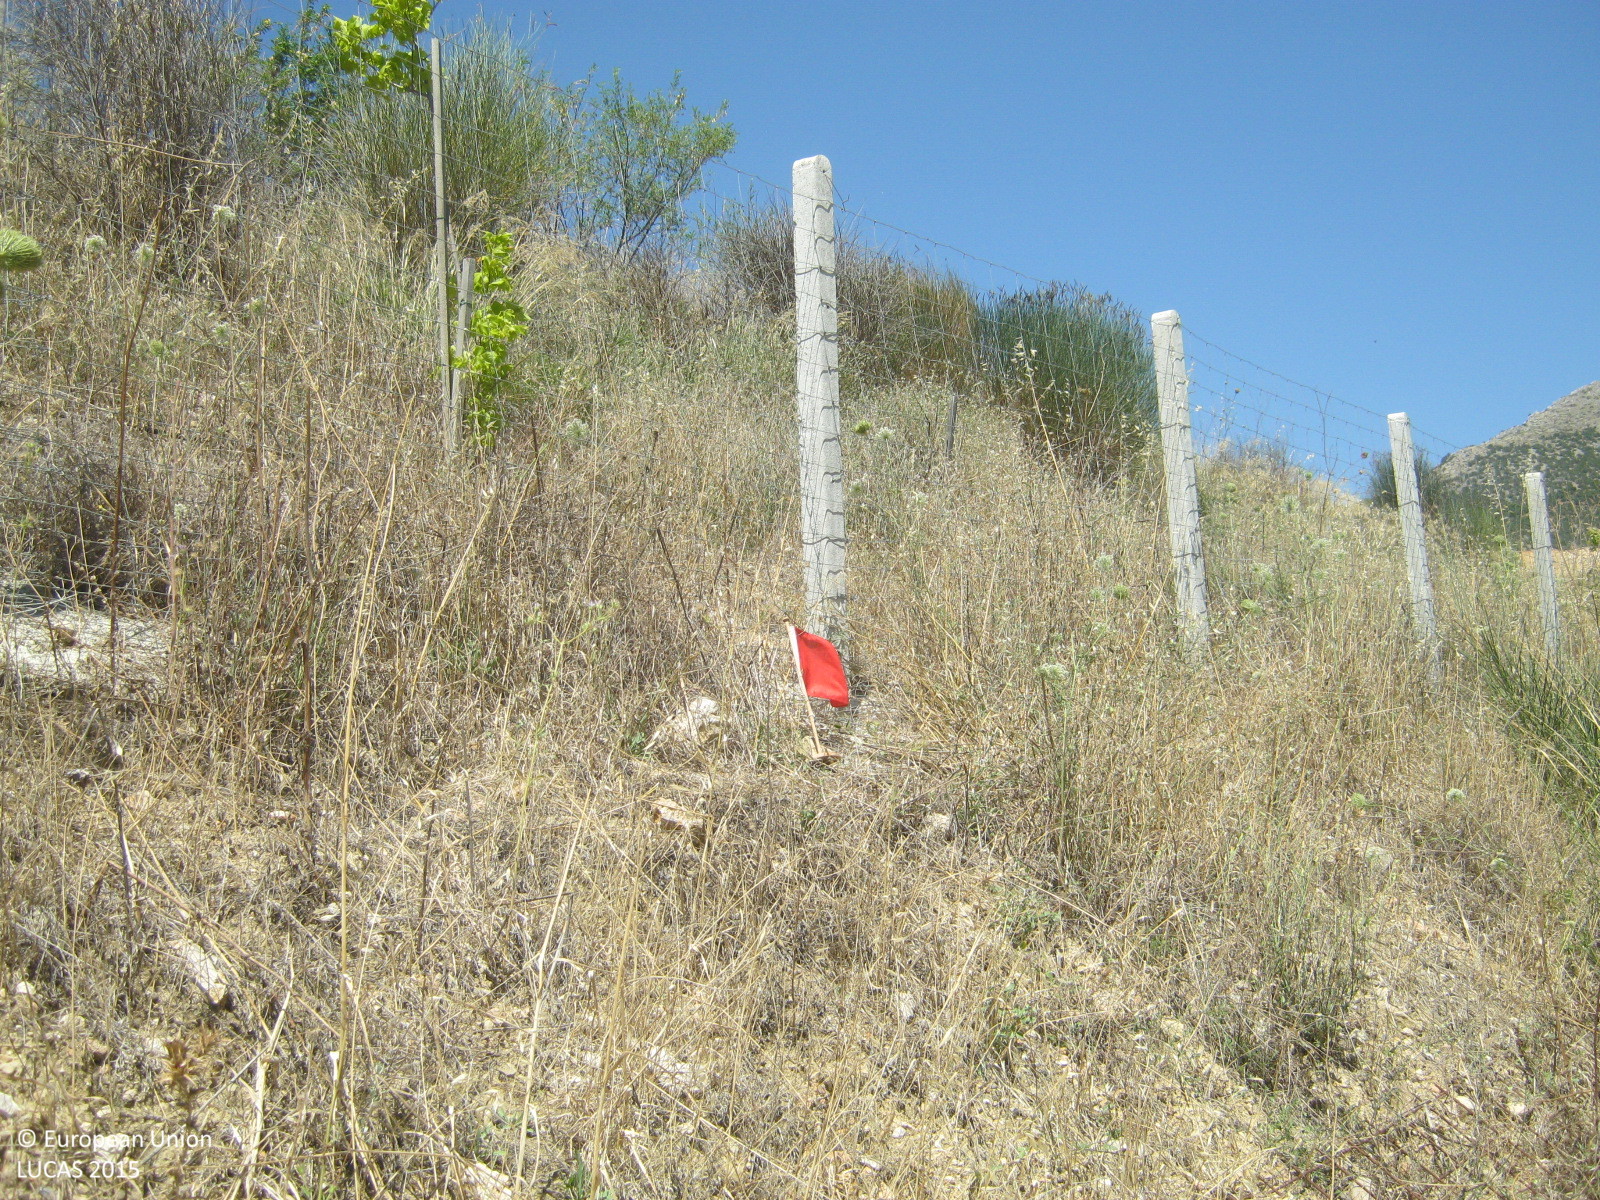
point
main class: Grassland
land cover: Grassland with sparse tree/shrub cover
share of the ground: > 75 %
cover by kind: herbaceous plants 80 %, unconsolidated bare surface 10 %, broadleaved forest trees 5 %, shrubs 5 %
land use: Semi-natural and natural areas not in use
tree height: < 5 m
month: July
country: GR
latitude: 37.8472
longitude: 22.8231
